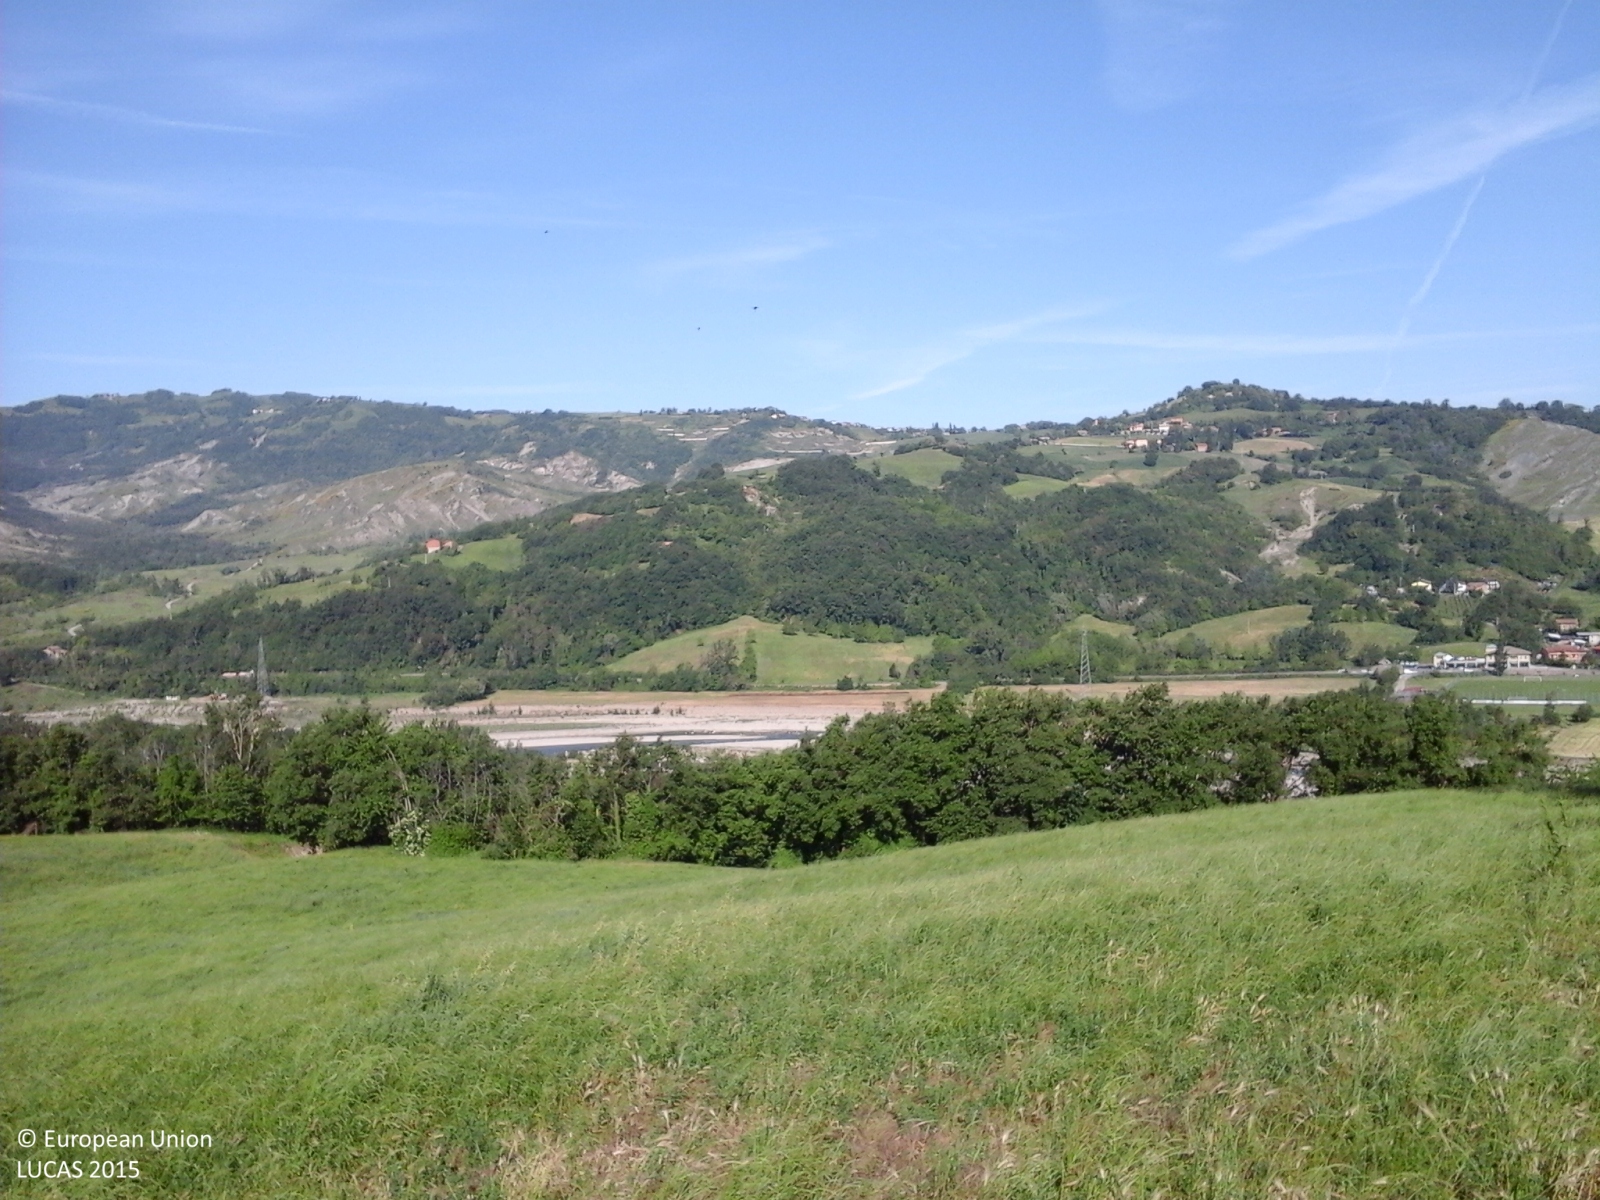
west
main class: Cropland
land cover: Lucerne
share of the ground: > 75 %
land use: Agriculture (excluding fallow land and kitchen gardens)
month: May
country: IT
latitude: 44.4566
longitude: 10.6646
